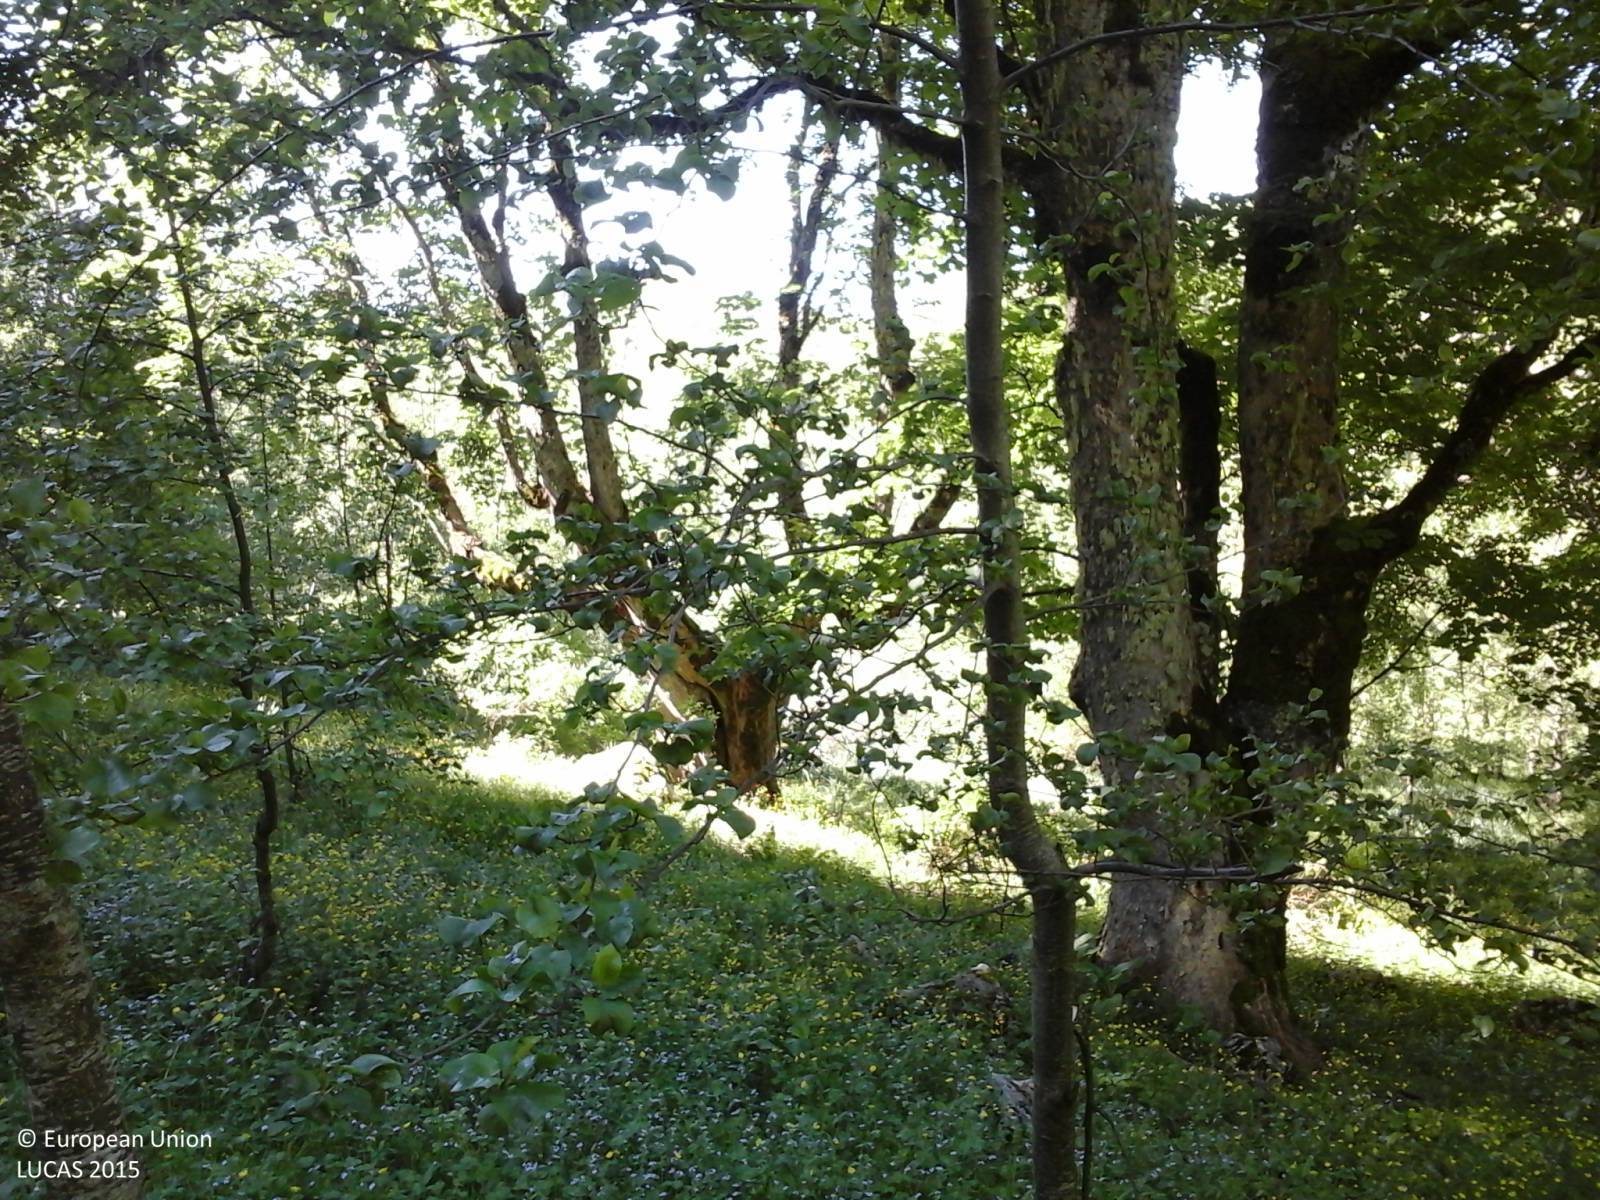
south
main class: Woodland
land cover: Broadleaved woodland
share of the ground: > 75 %
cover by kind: broadleaved forest trees 80 %, herbaceous plants 15 %, shrubs 5 %
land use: Semi-natural and natural areas not in use
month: May
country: IT
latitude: 42.0065
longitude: 13.2125
